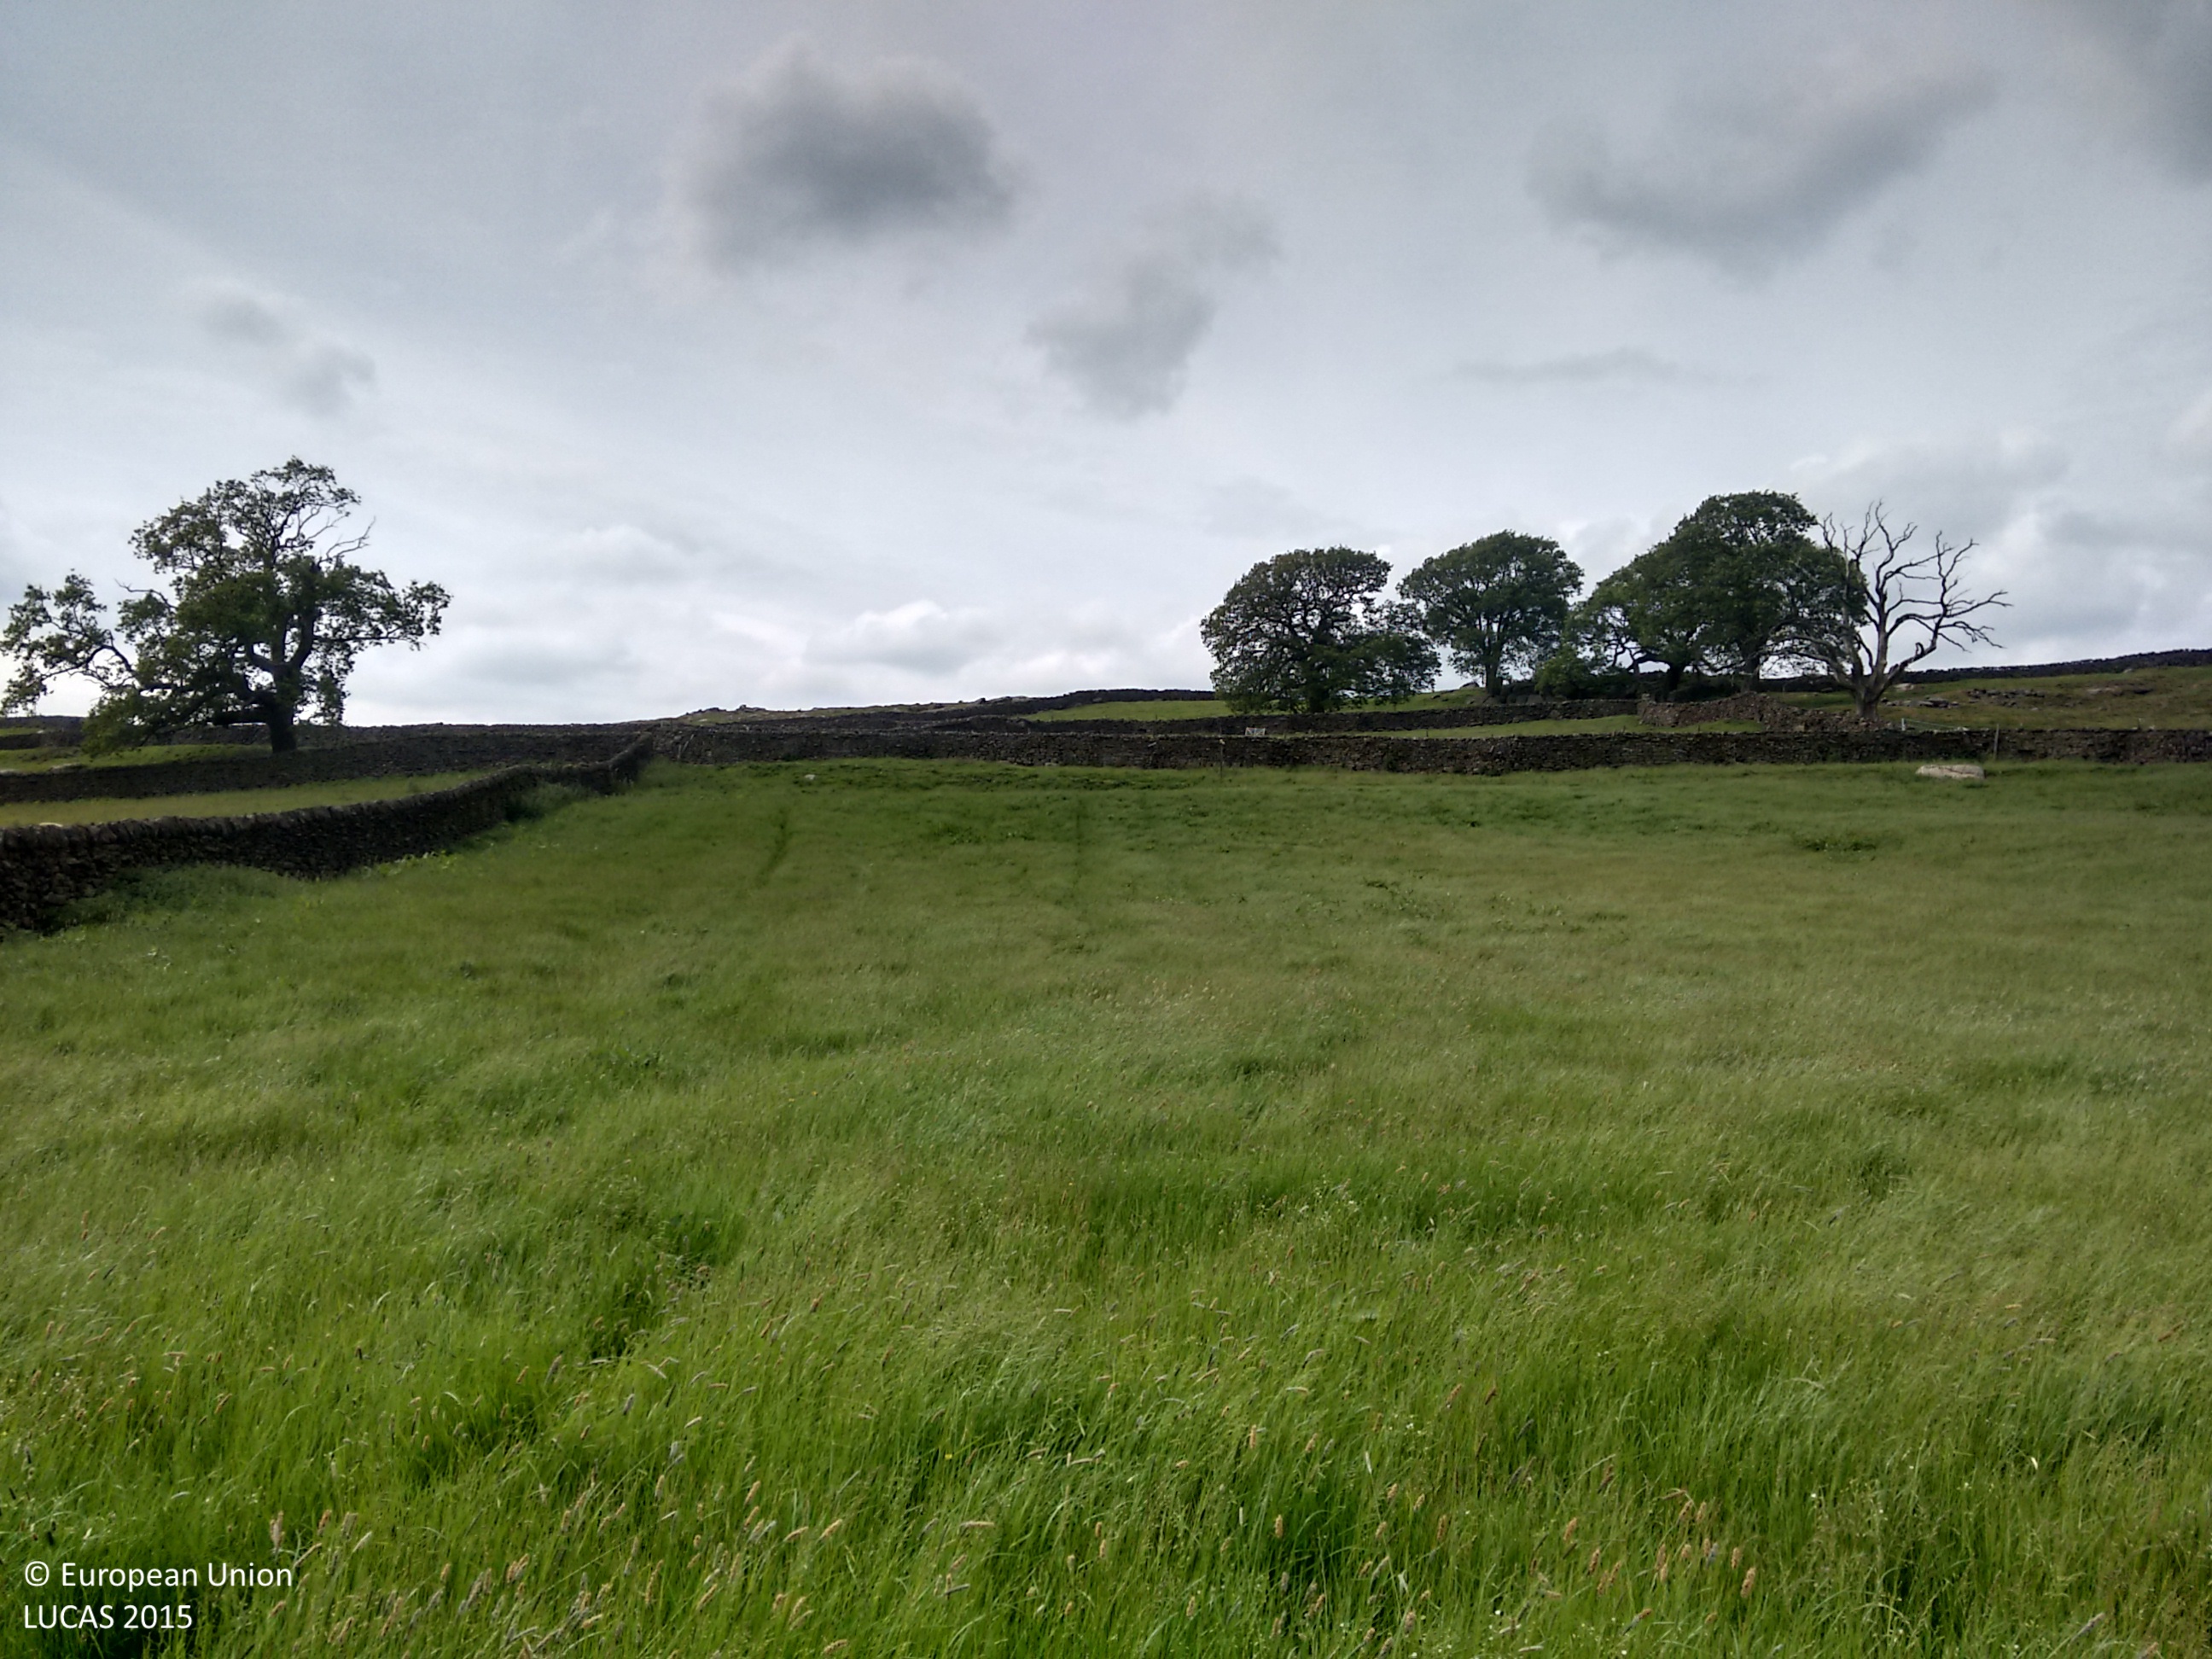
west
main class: Grassland
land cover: Grassland without tree/shrub cover
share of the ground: > 75 %
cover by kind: herbaceous plants 100 %
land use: Agriculture (excluding fallow land and kitchen gardens)
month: June
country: GB
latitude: 54.0292
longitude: -1.9174
